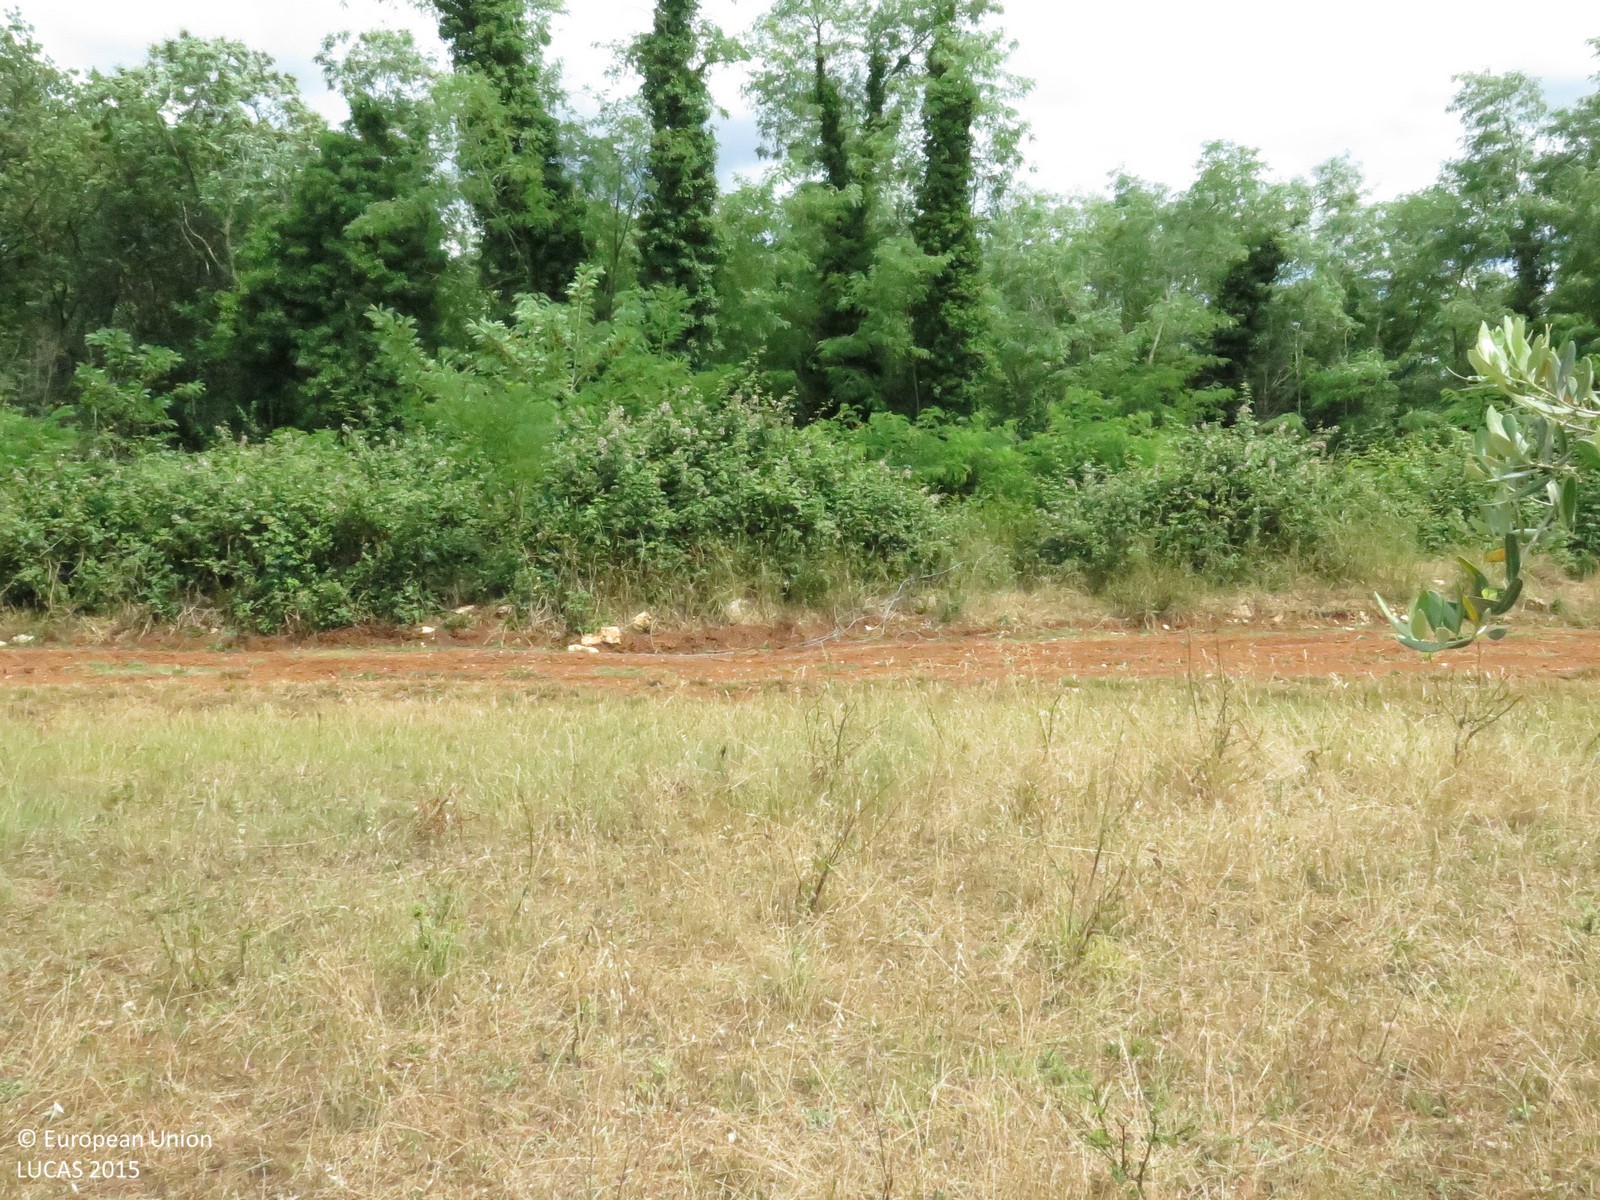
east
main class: Cropland
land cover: Olive groves
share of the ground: 50 - 75 %
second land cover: Grassland without tree/shrub cover
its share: > 75 %
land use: Agriculture (excluding fallow land and kitchen gardens)
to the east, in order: Olive groves; Grassland without tree/shrub cover; Tracks; Shrubland with sparse tree cover; Dry stone walls; Shrubland with sparse tree cover; Broadleaved woodland; Dry stone walls; Tracks; Broadleaved woodland; Grassland with sparse tree/shrub cover; Broadleaved woodland
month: June
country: HR
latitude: 45.2771
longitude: 13.7044
